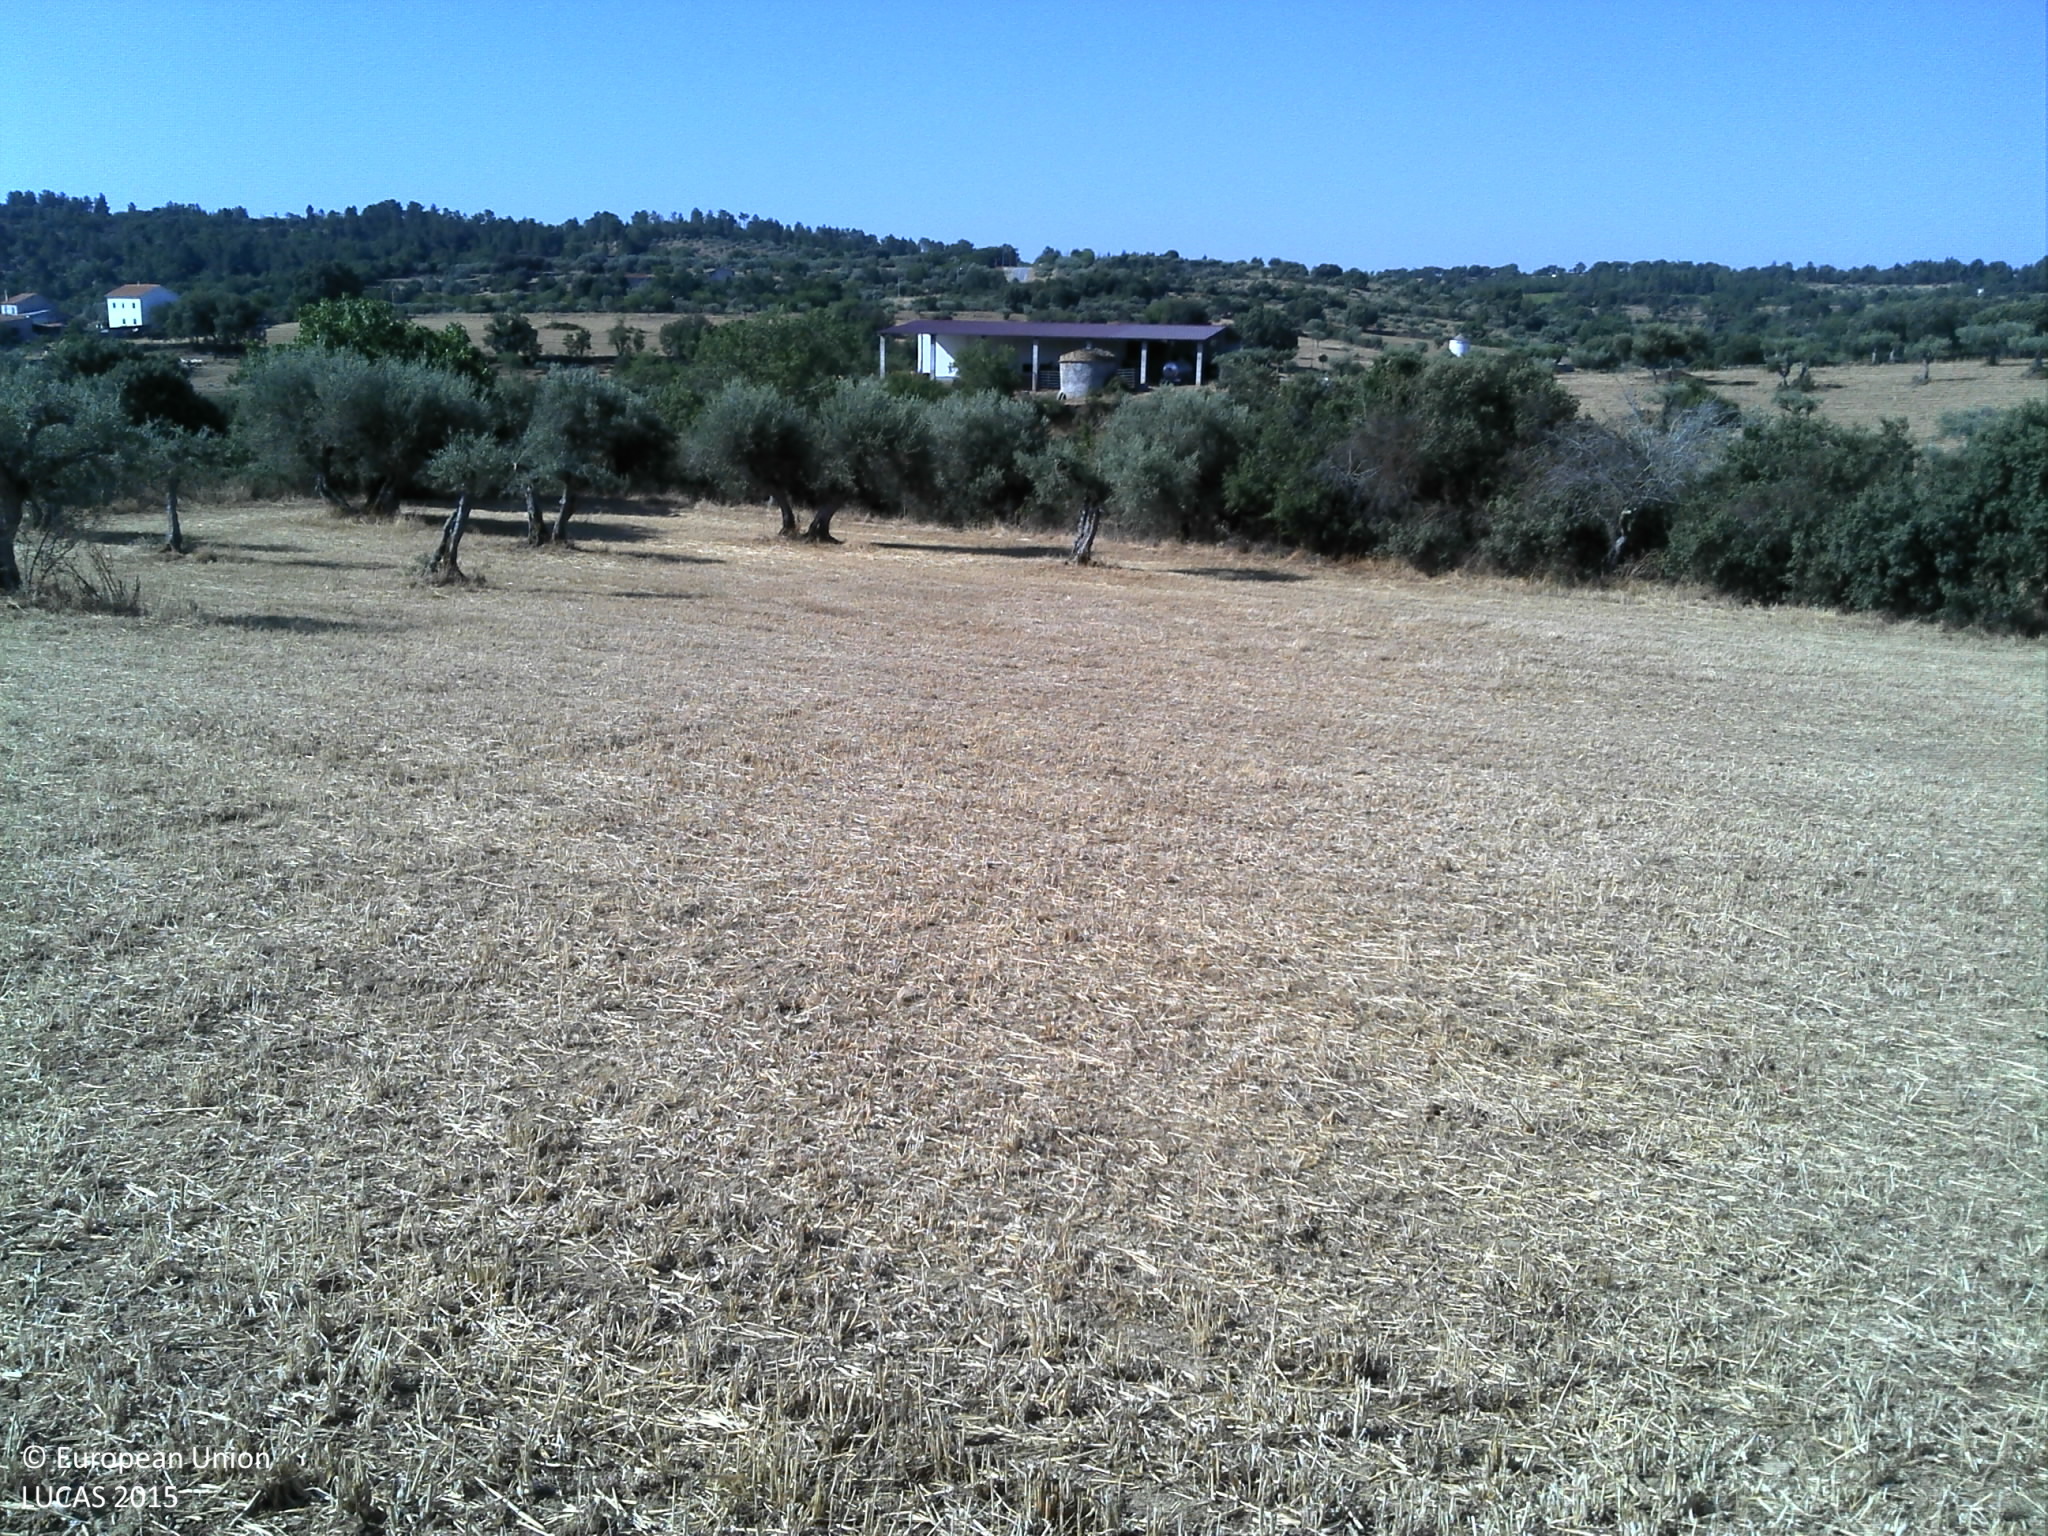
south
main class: Cropland
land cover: Oats
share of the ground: > 75 %
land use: Agriculture (excluding fallow land and kitchen gardens)
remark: Harvested field
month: June
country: PT
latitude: 40.8460
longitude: -6.8363
